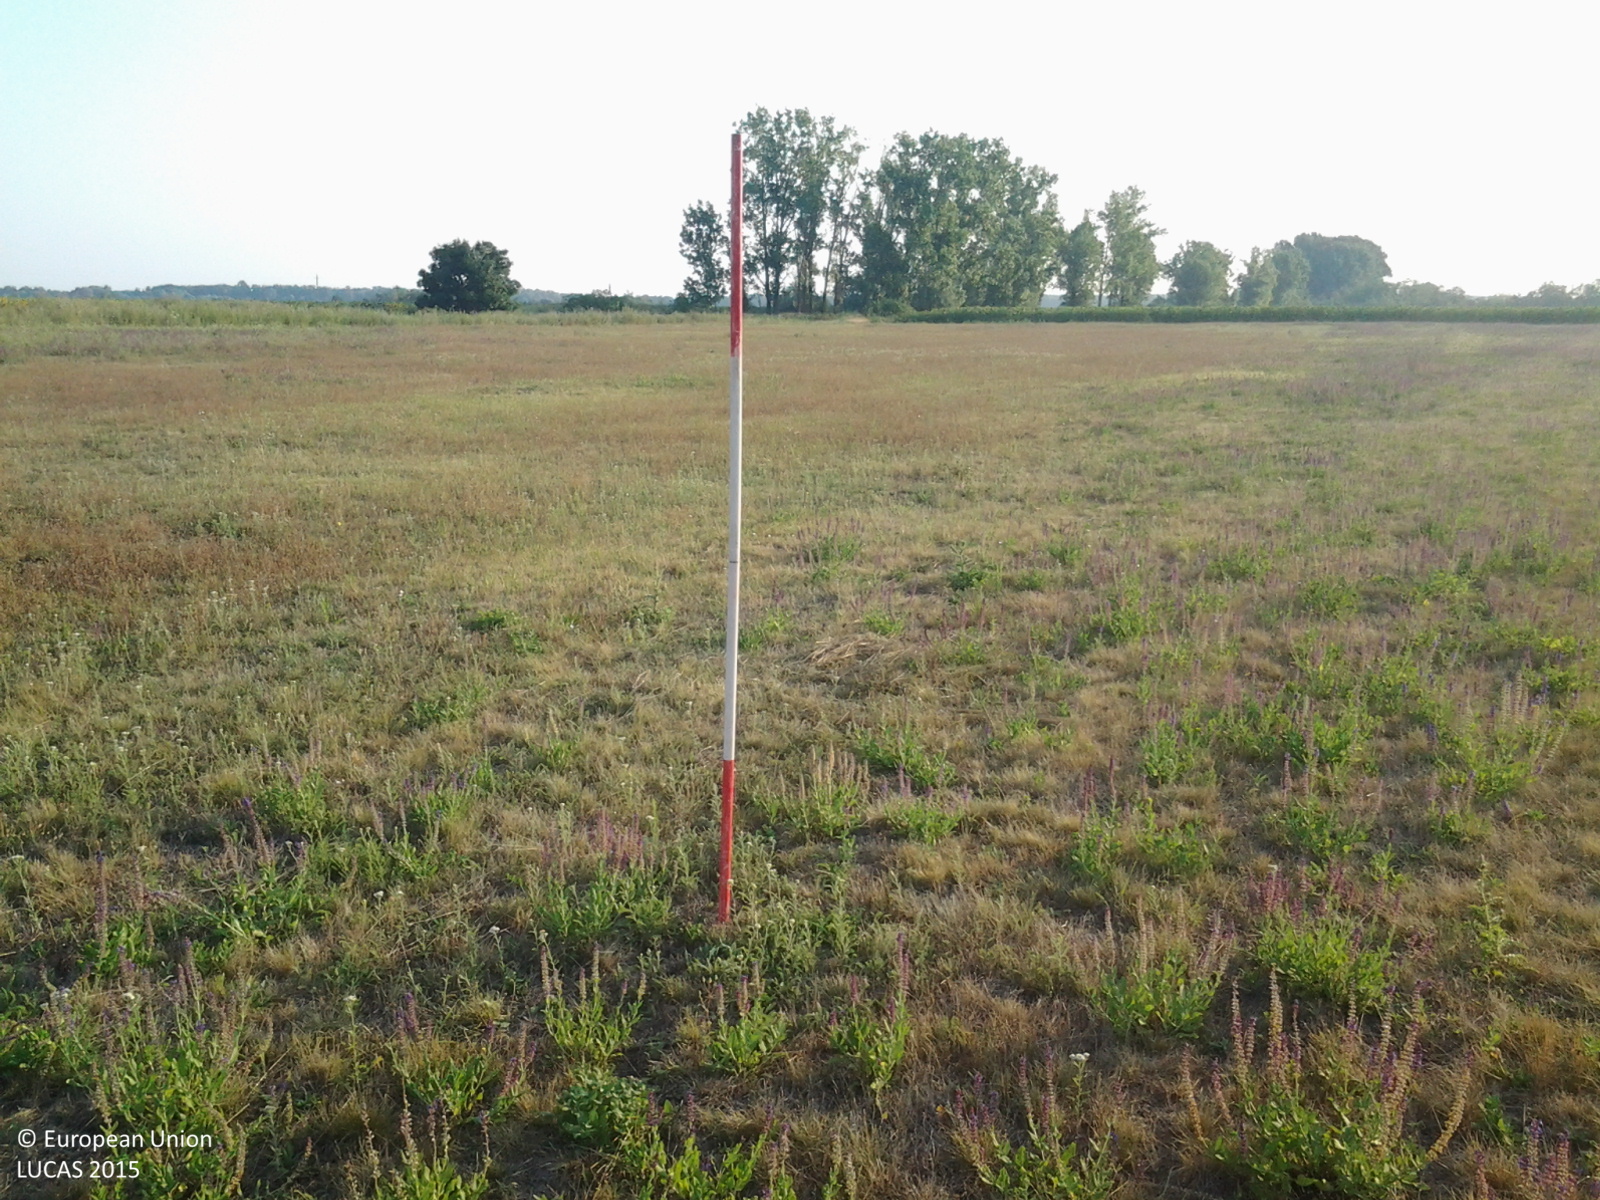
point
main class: Grassland
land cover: Grassland without tree/shrub cover
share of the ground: > 75 %
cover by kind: herbaceous plants 100 %
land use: Agriculture (excluding fallow land and kitchen gardens)
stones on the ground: < 10 %
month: July
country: HU
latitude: 46.9017
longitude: 20.8887
